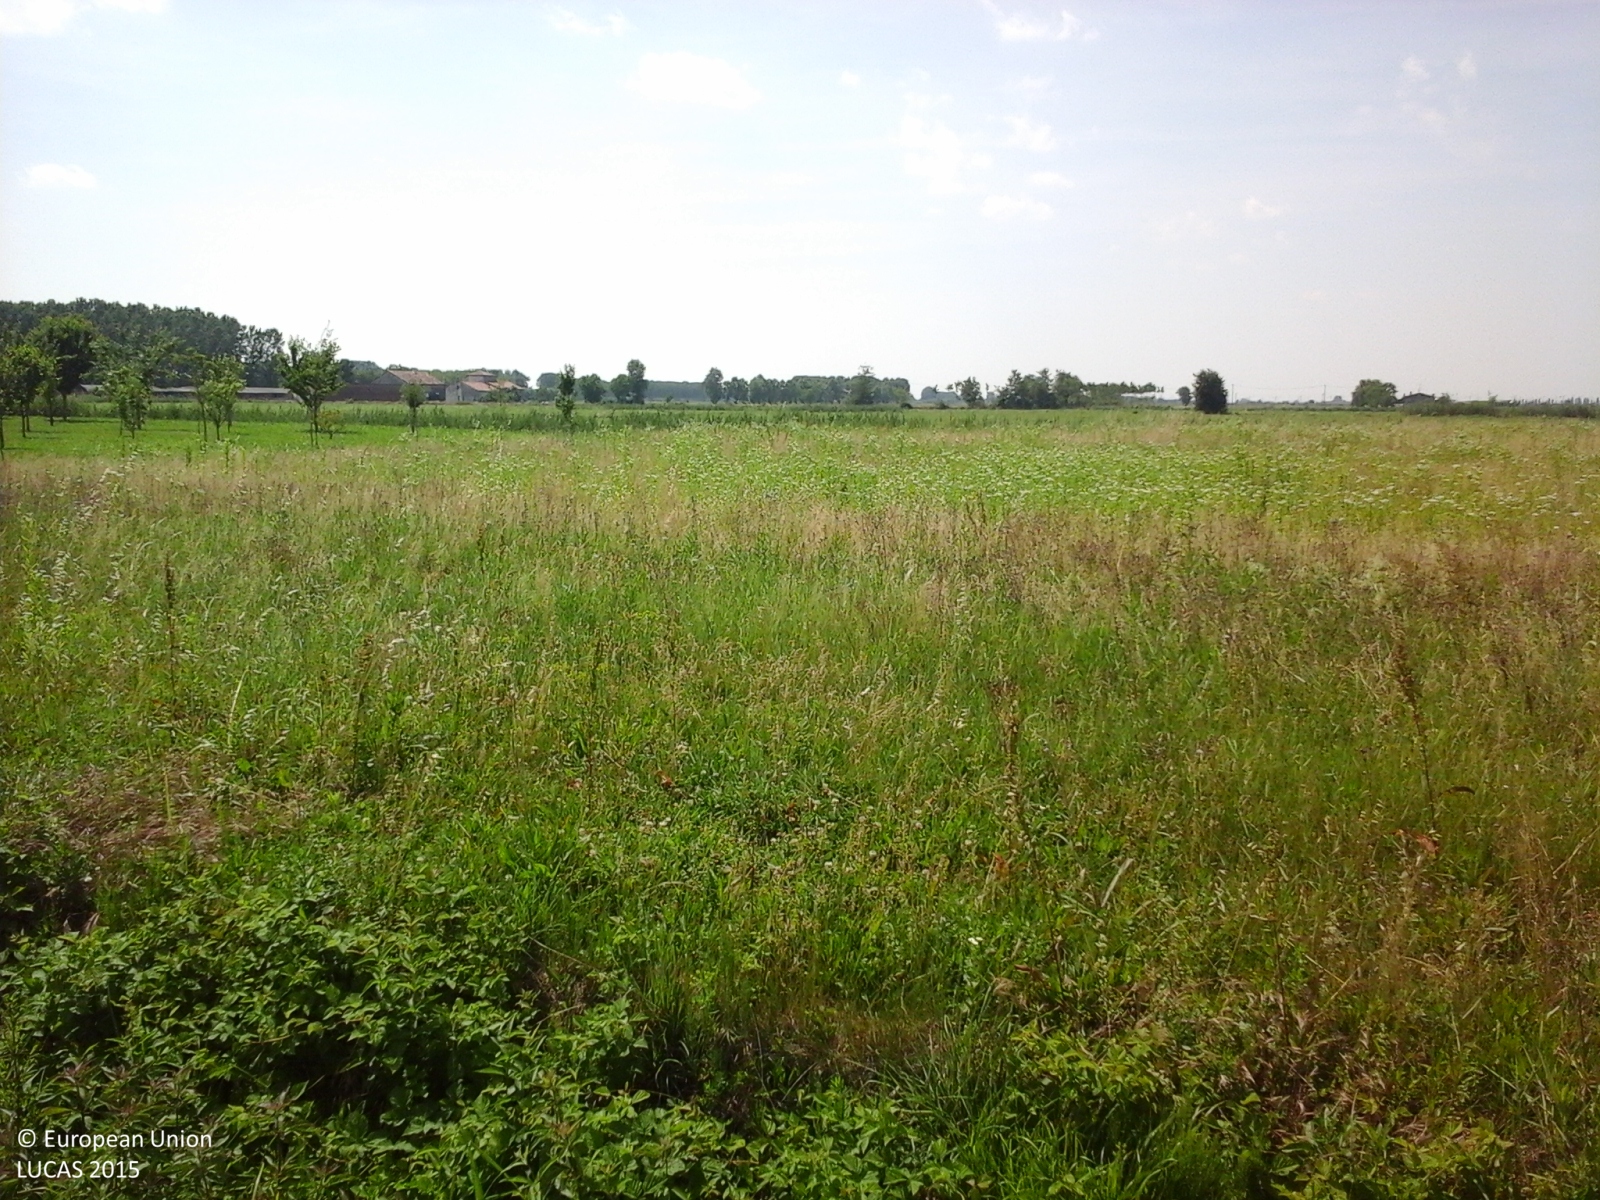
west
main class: Grassland
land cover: Grassland without tree/shrub cover
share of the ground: > 75 %
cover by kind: herbaceous plants 100 %
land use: Agriculture (excluding fallow land and kitchen gardens)
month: May
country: IT
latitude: 45.1757
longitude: 10.9526
